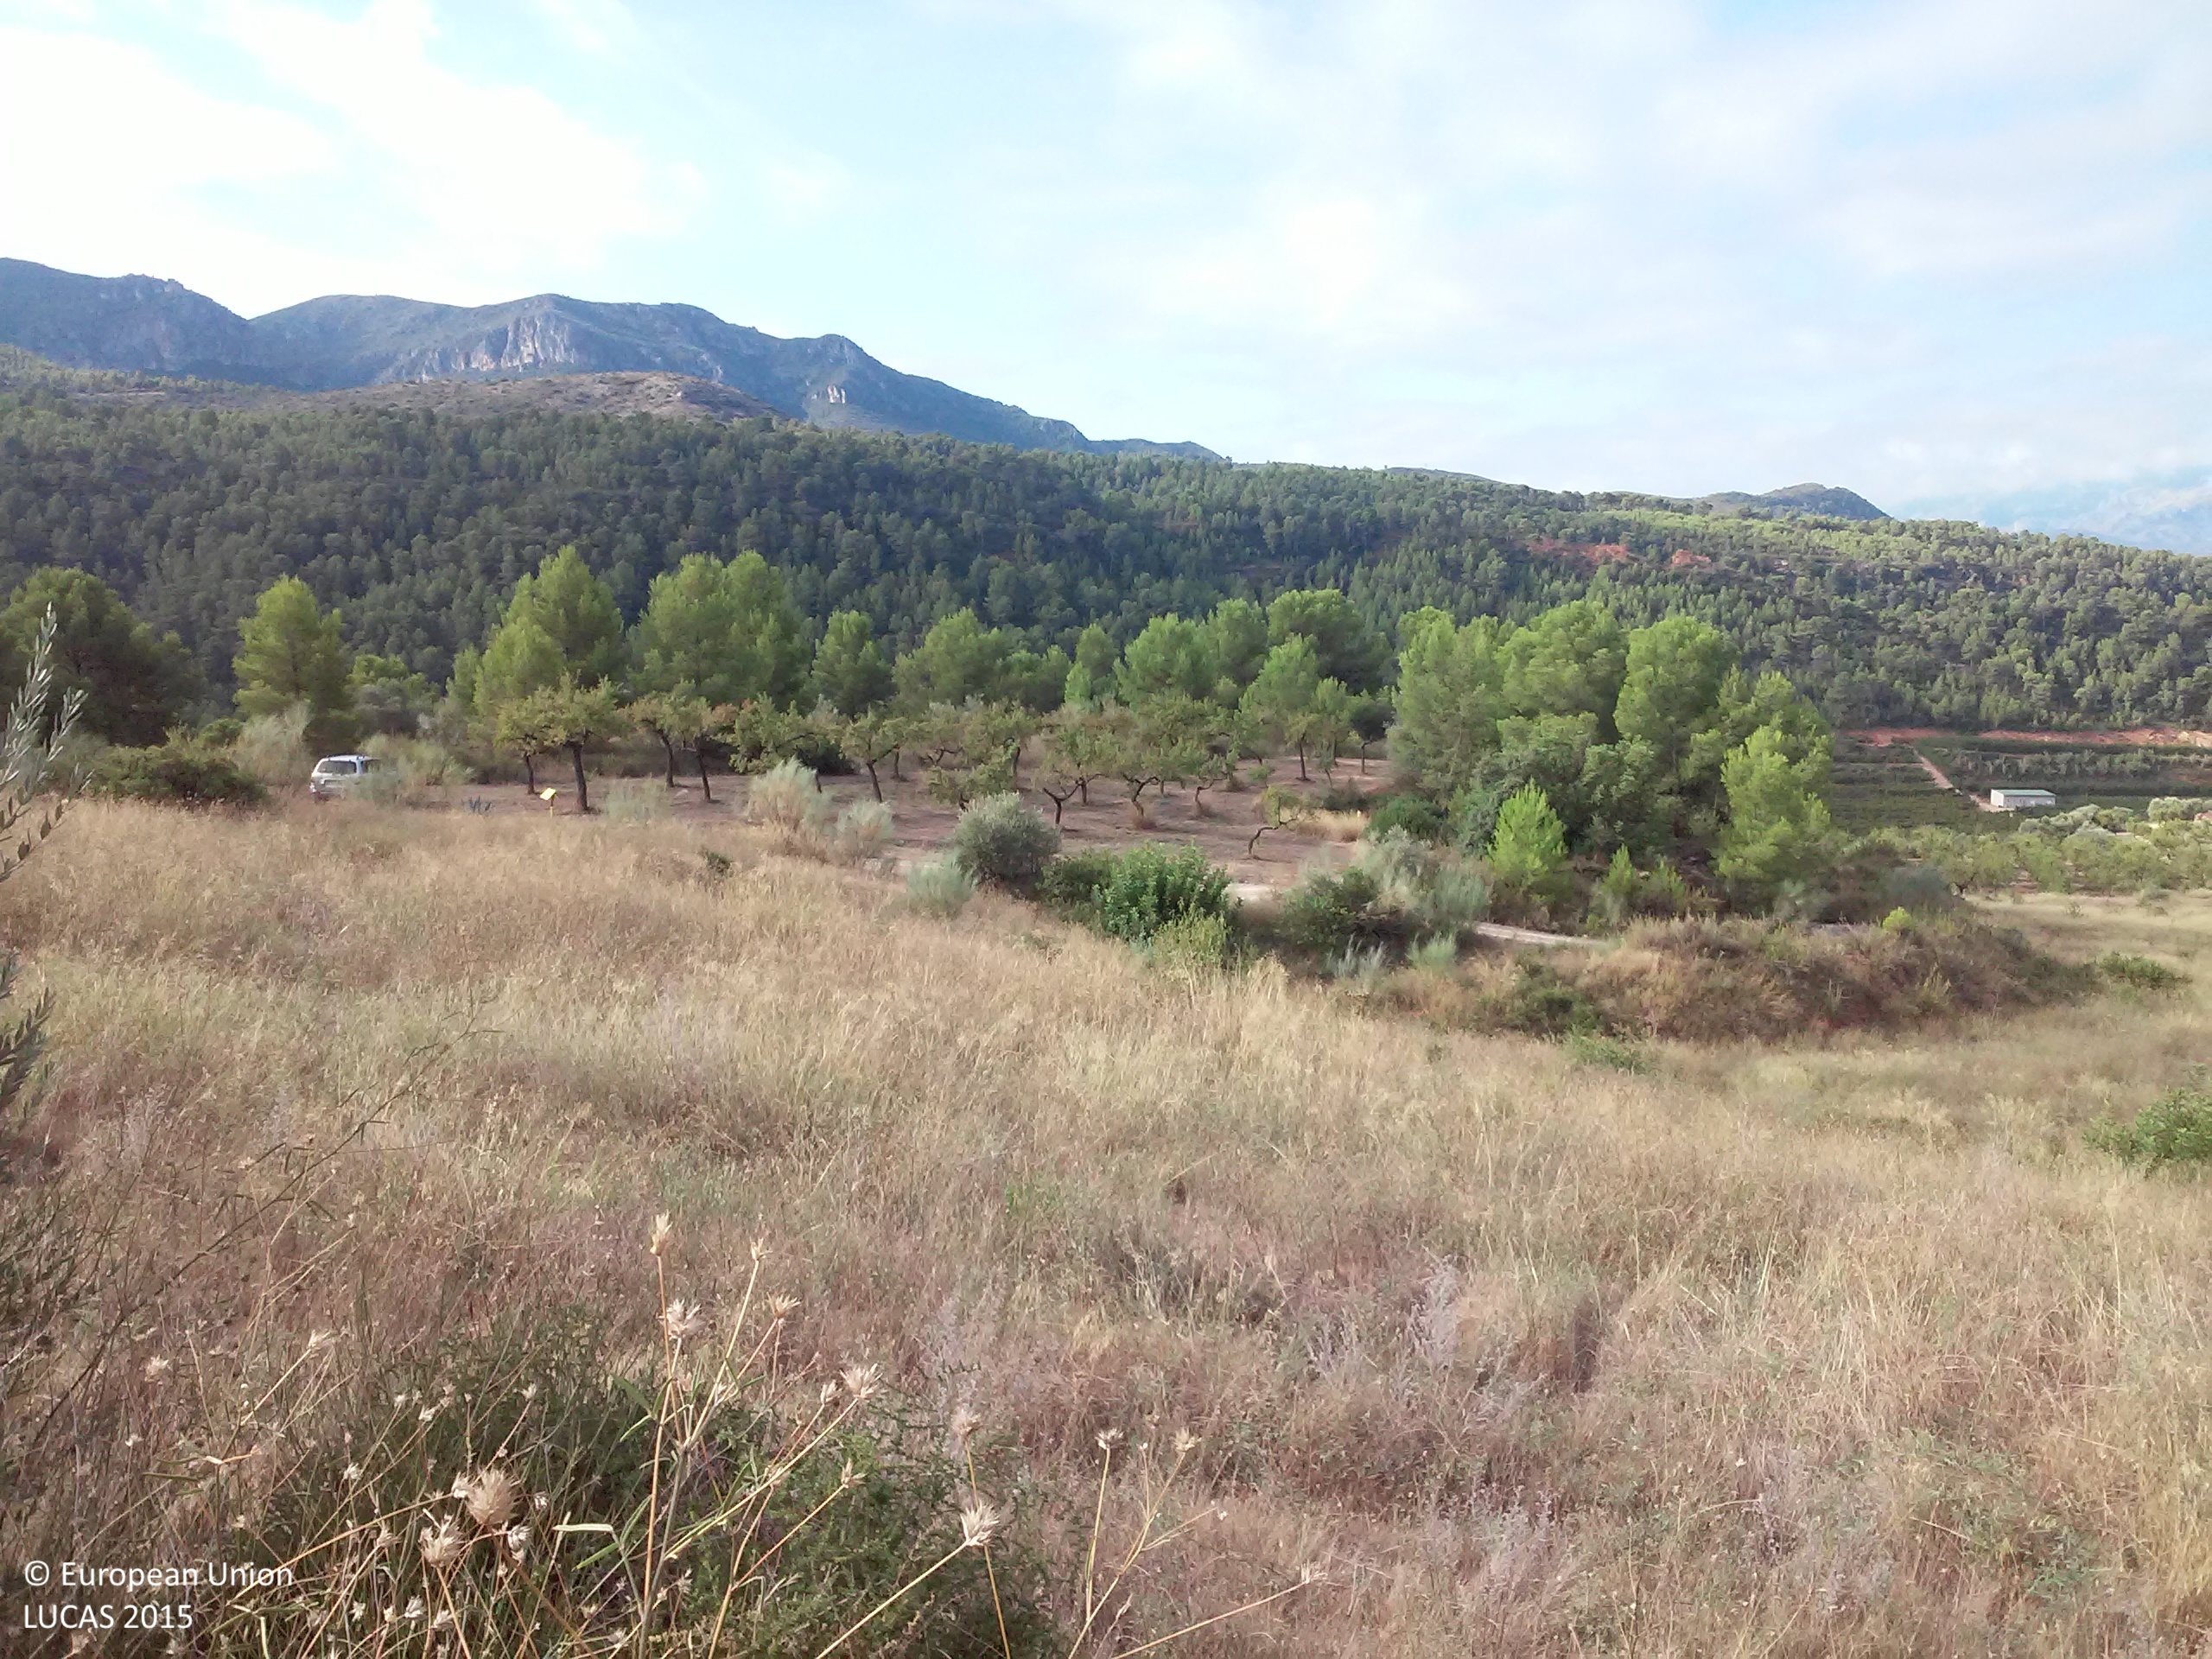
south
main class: Grassland
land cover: Spontaneously vegetated surfaces
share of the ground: > 75 %
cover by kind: herbaceous plants 95 %, consolidated bare surface 5 %
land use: Fallow land
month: August
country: ES
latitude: 41.0596
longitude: 0.6753
